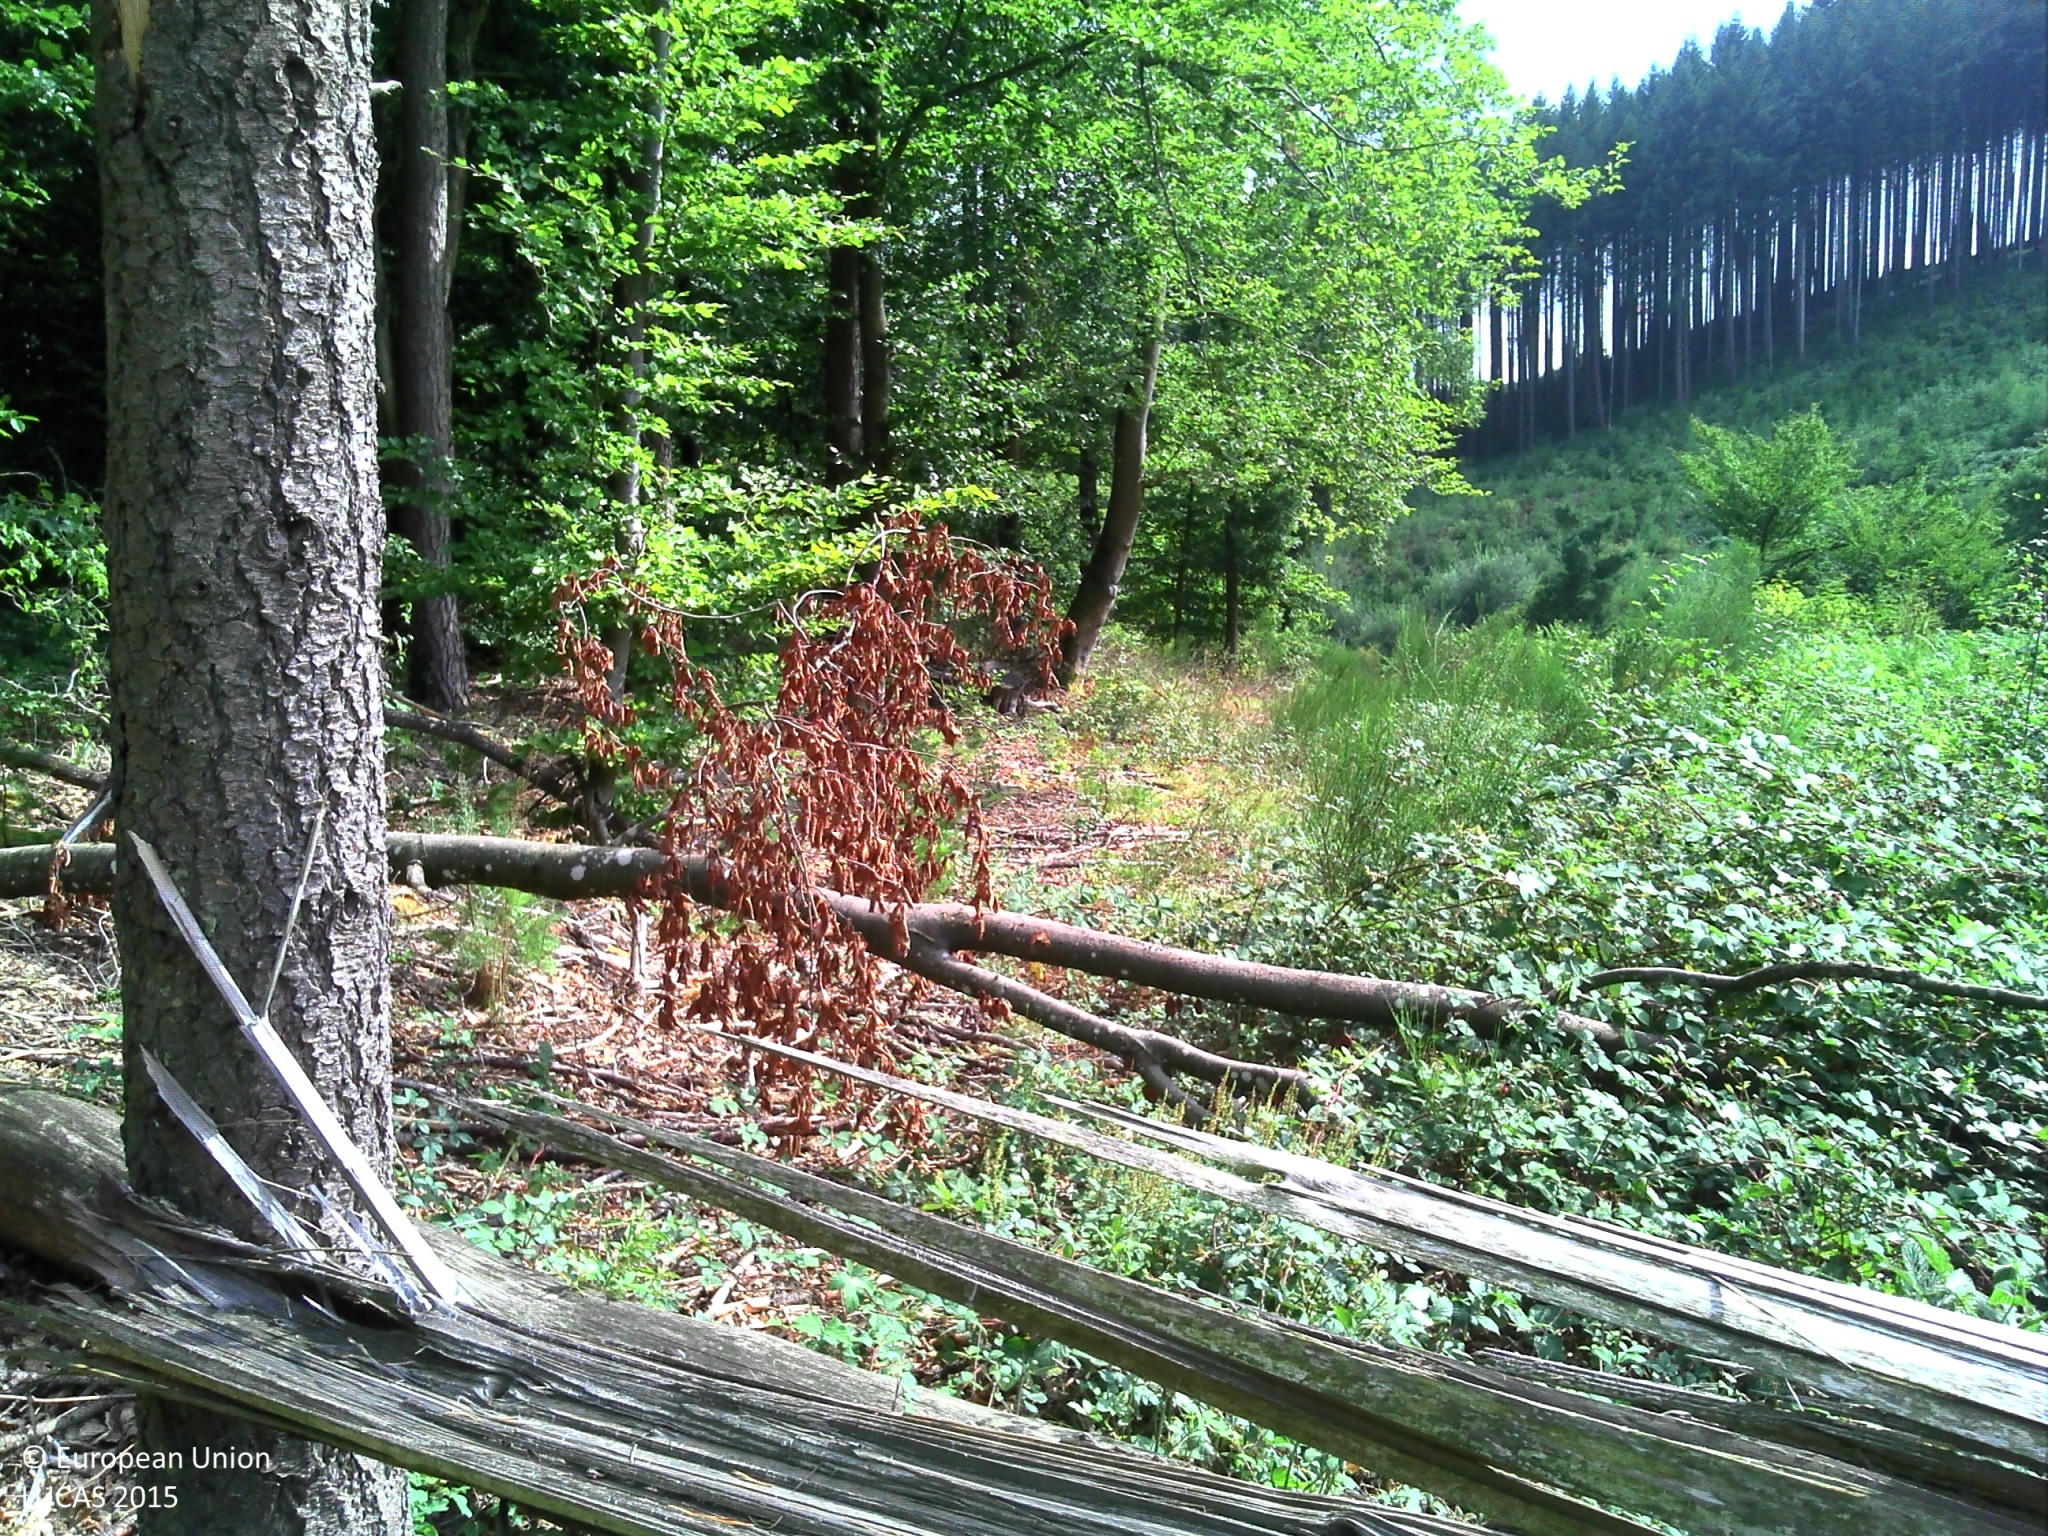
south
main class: Shrubland
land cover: Shrubland without tree cover
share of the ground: > 75 %
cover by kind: shrubs 80 %, herbaceous plants 20 %
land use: Forestry
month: August
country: FR
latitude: 46.2951
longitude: 4.4066
